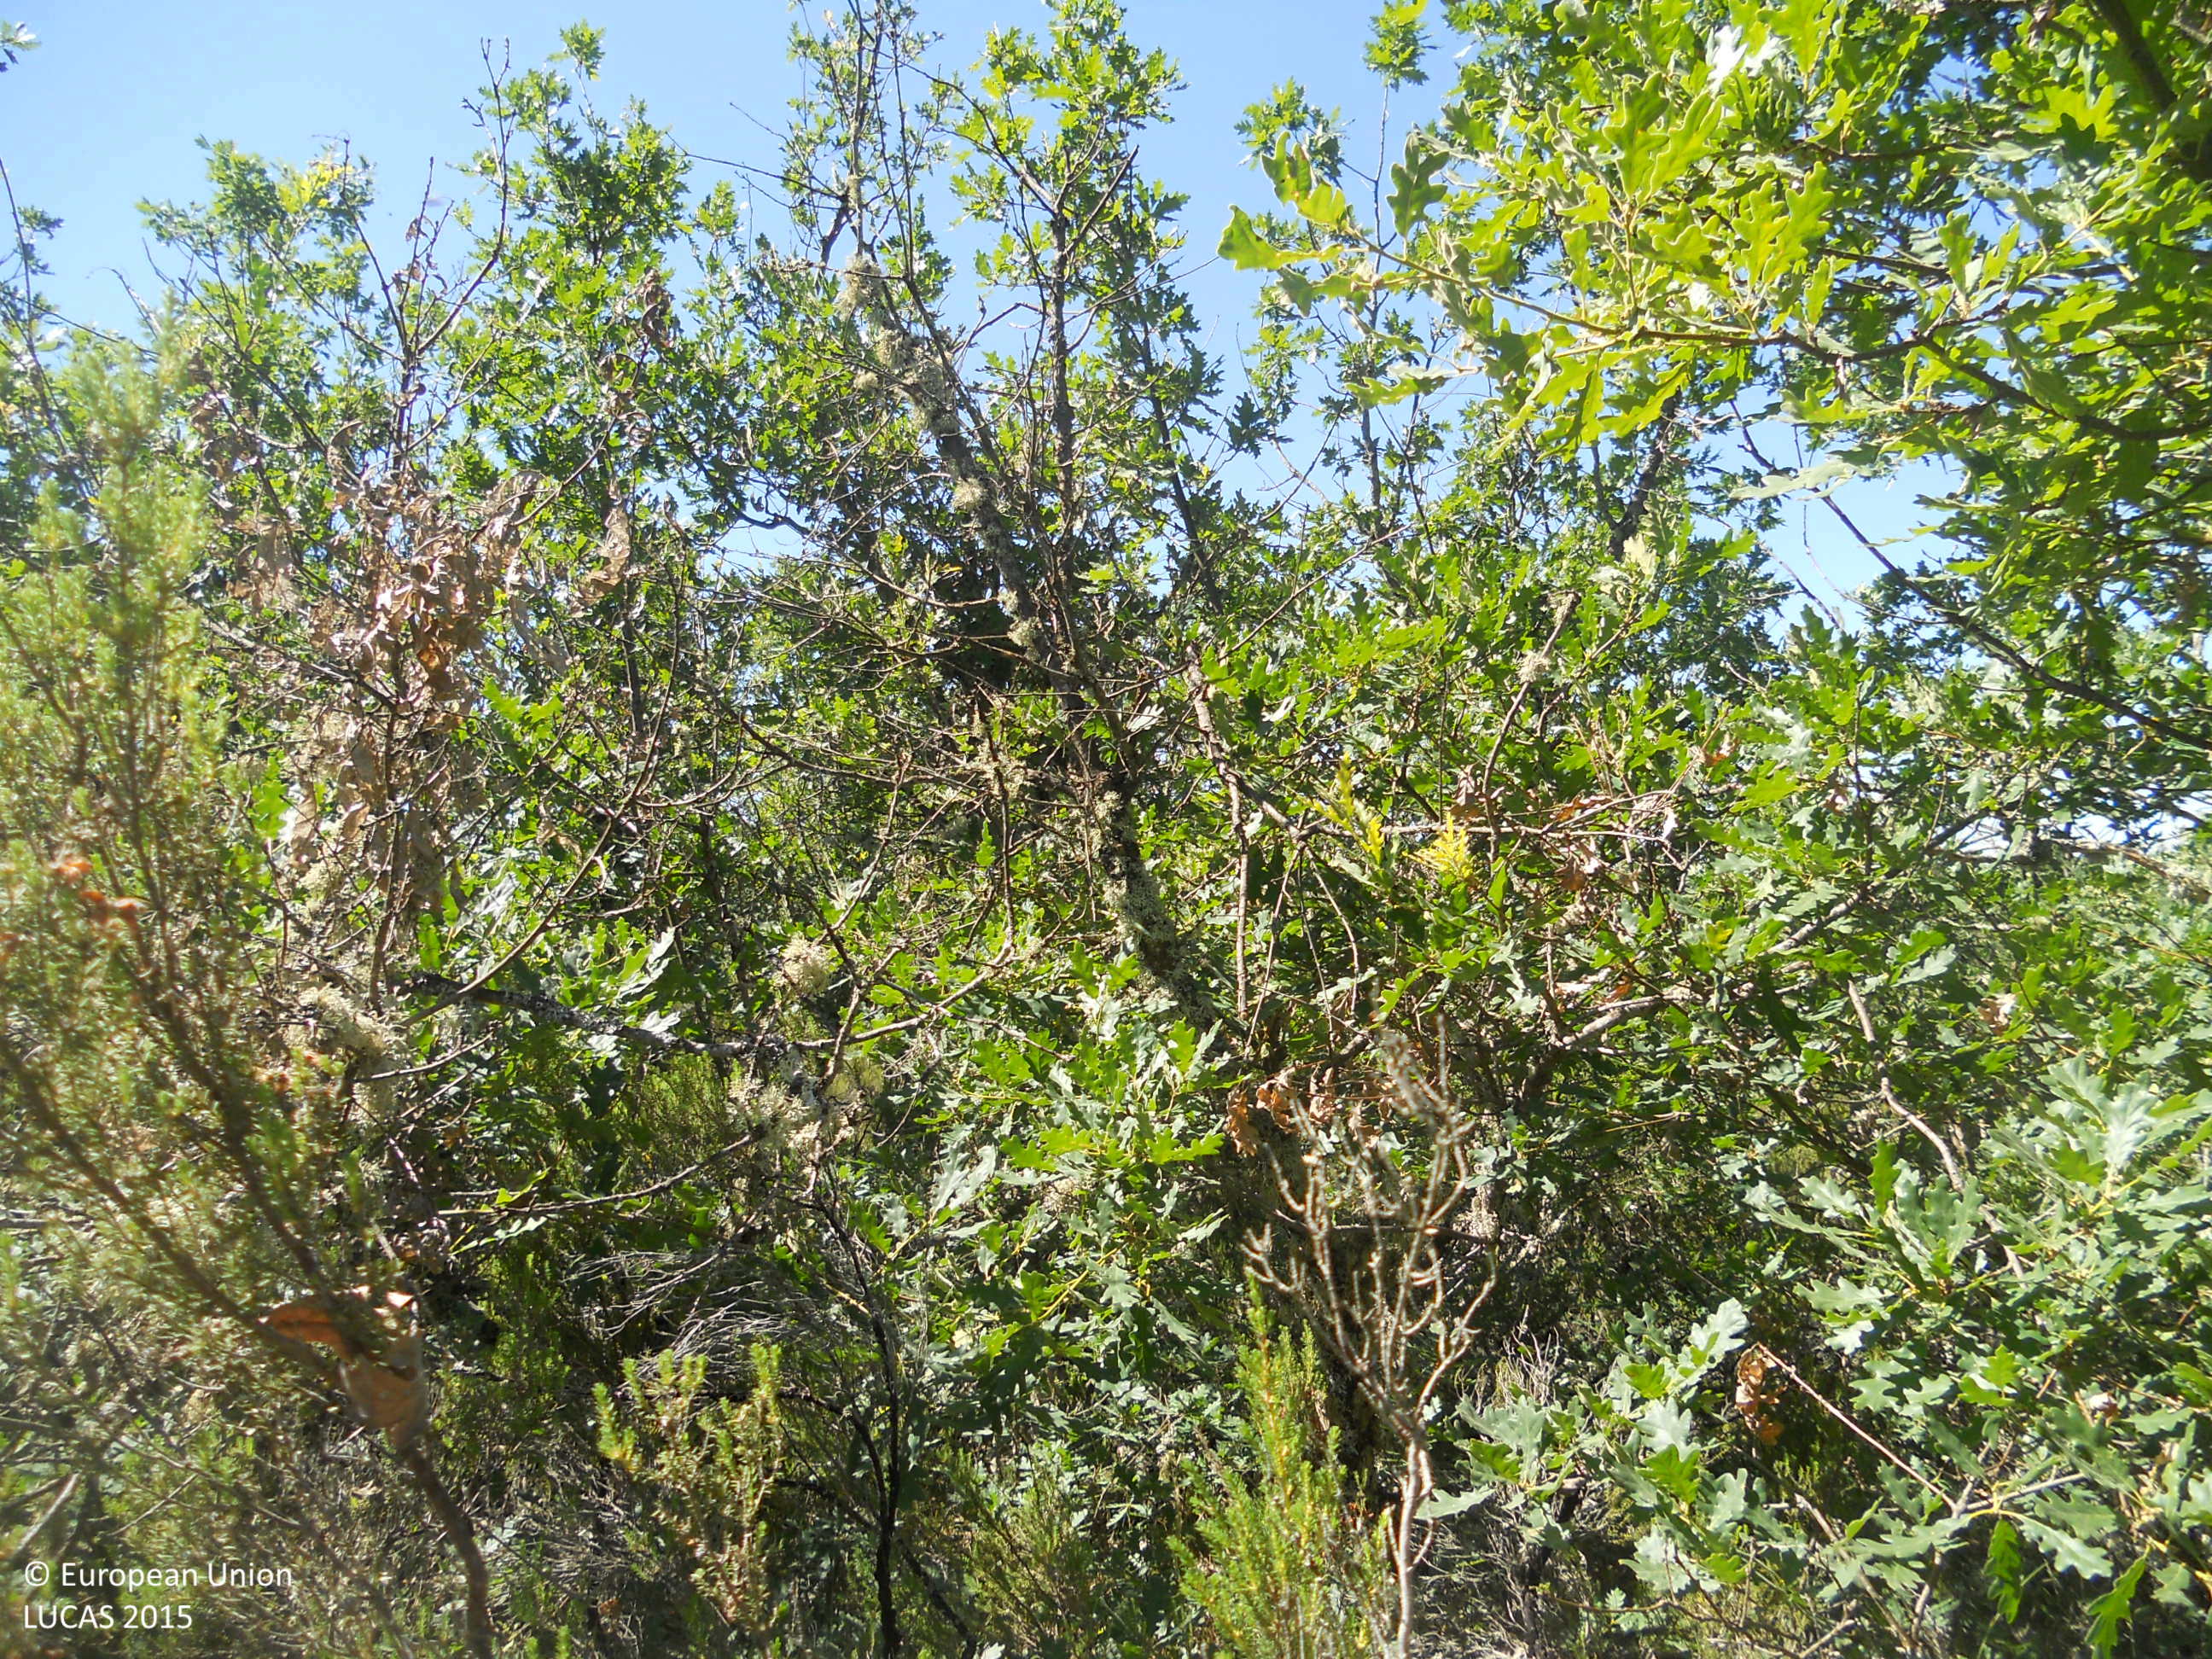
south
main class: Woodland
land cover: Broadleaved woodland
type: acidophilous oak and oak-birch forest
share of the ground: 50 - 75 %
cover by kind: broadleaved forest trees 70 %, shrubs 25 %, herbaceous plants 5 %
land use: Forestry
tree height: > 5 m
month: June
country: ES
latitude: 42.6194
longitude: -4.9467
